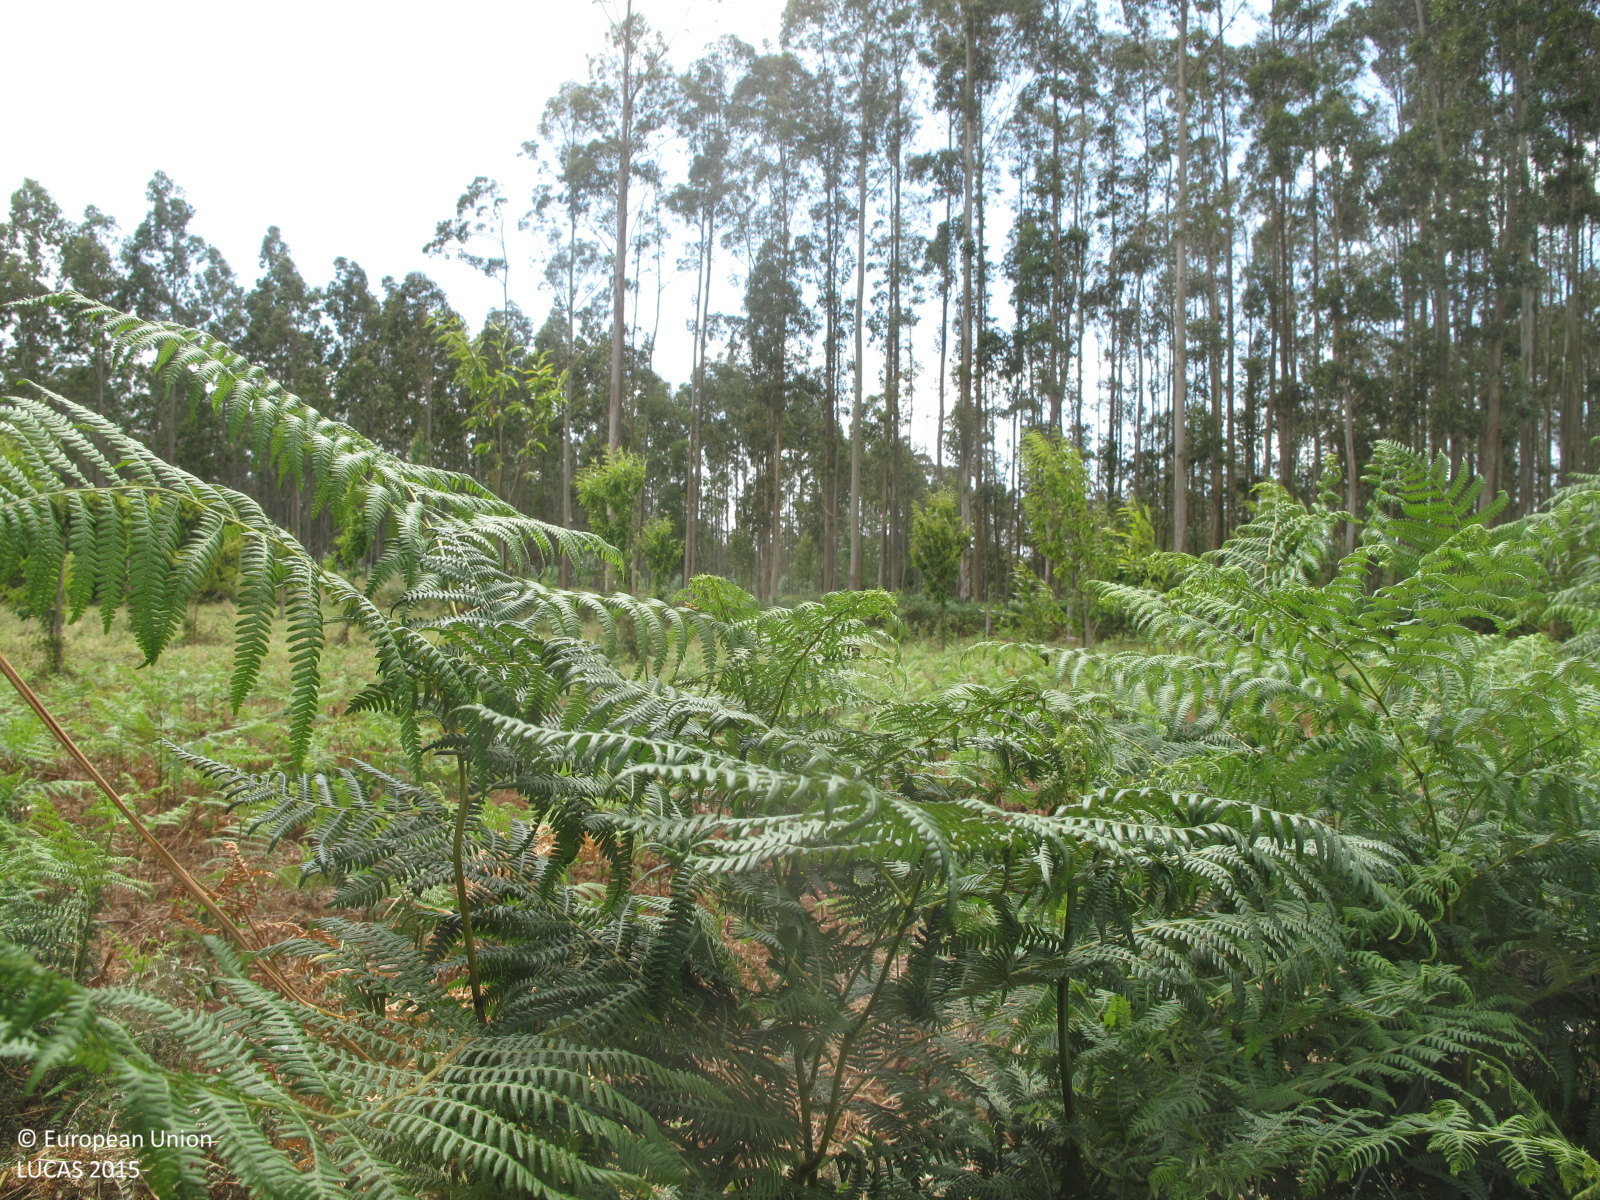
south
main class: Grassland
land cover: Grassland with sparse tree/shrub cover
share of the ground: > 75 %
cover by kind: herbaceous plants 90 %, broadleaved forest trees 5 %, unconsolidated bare surface 5 %
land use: Forestry
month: July
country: ES
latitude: 43.4522
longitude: -8.1548
